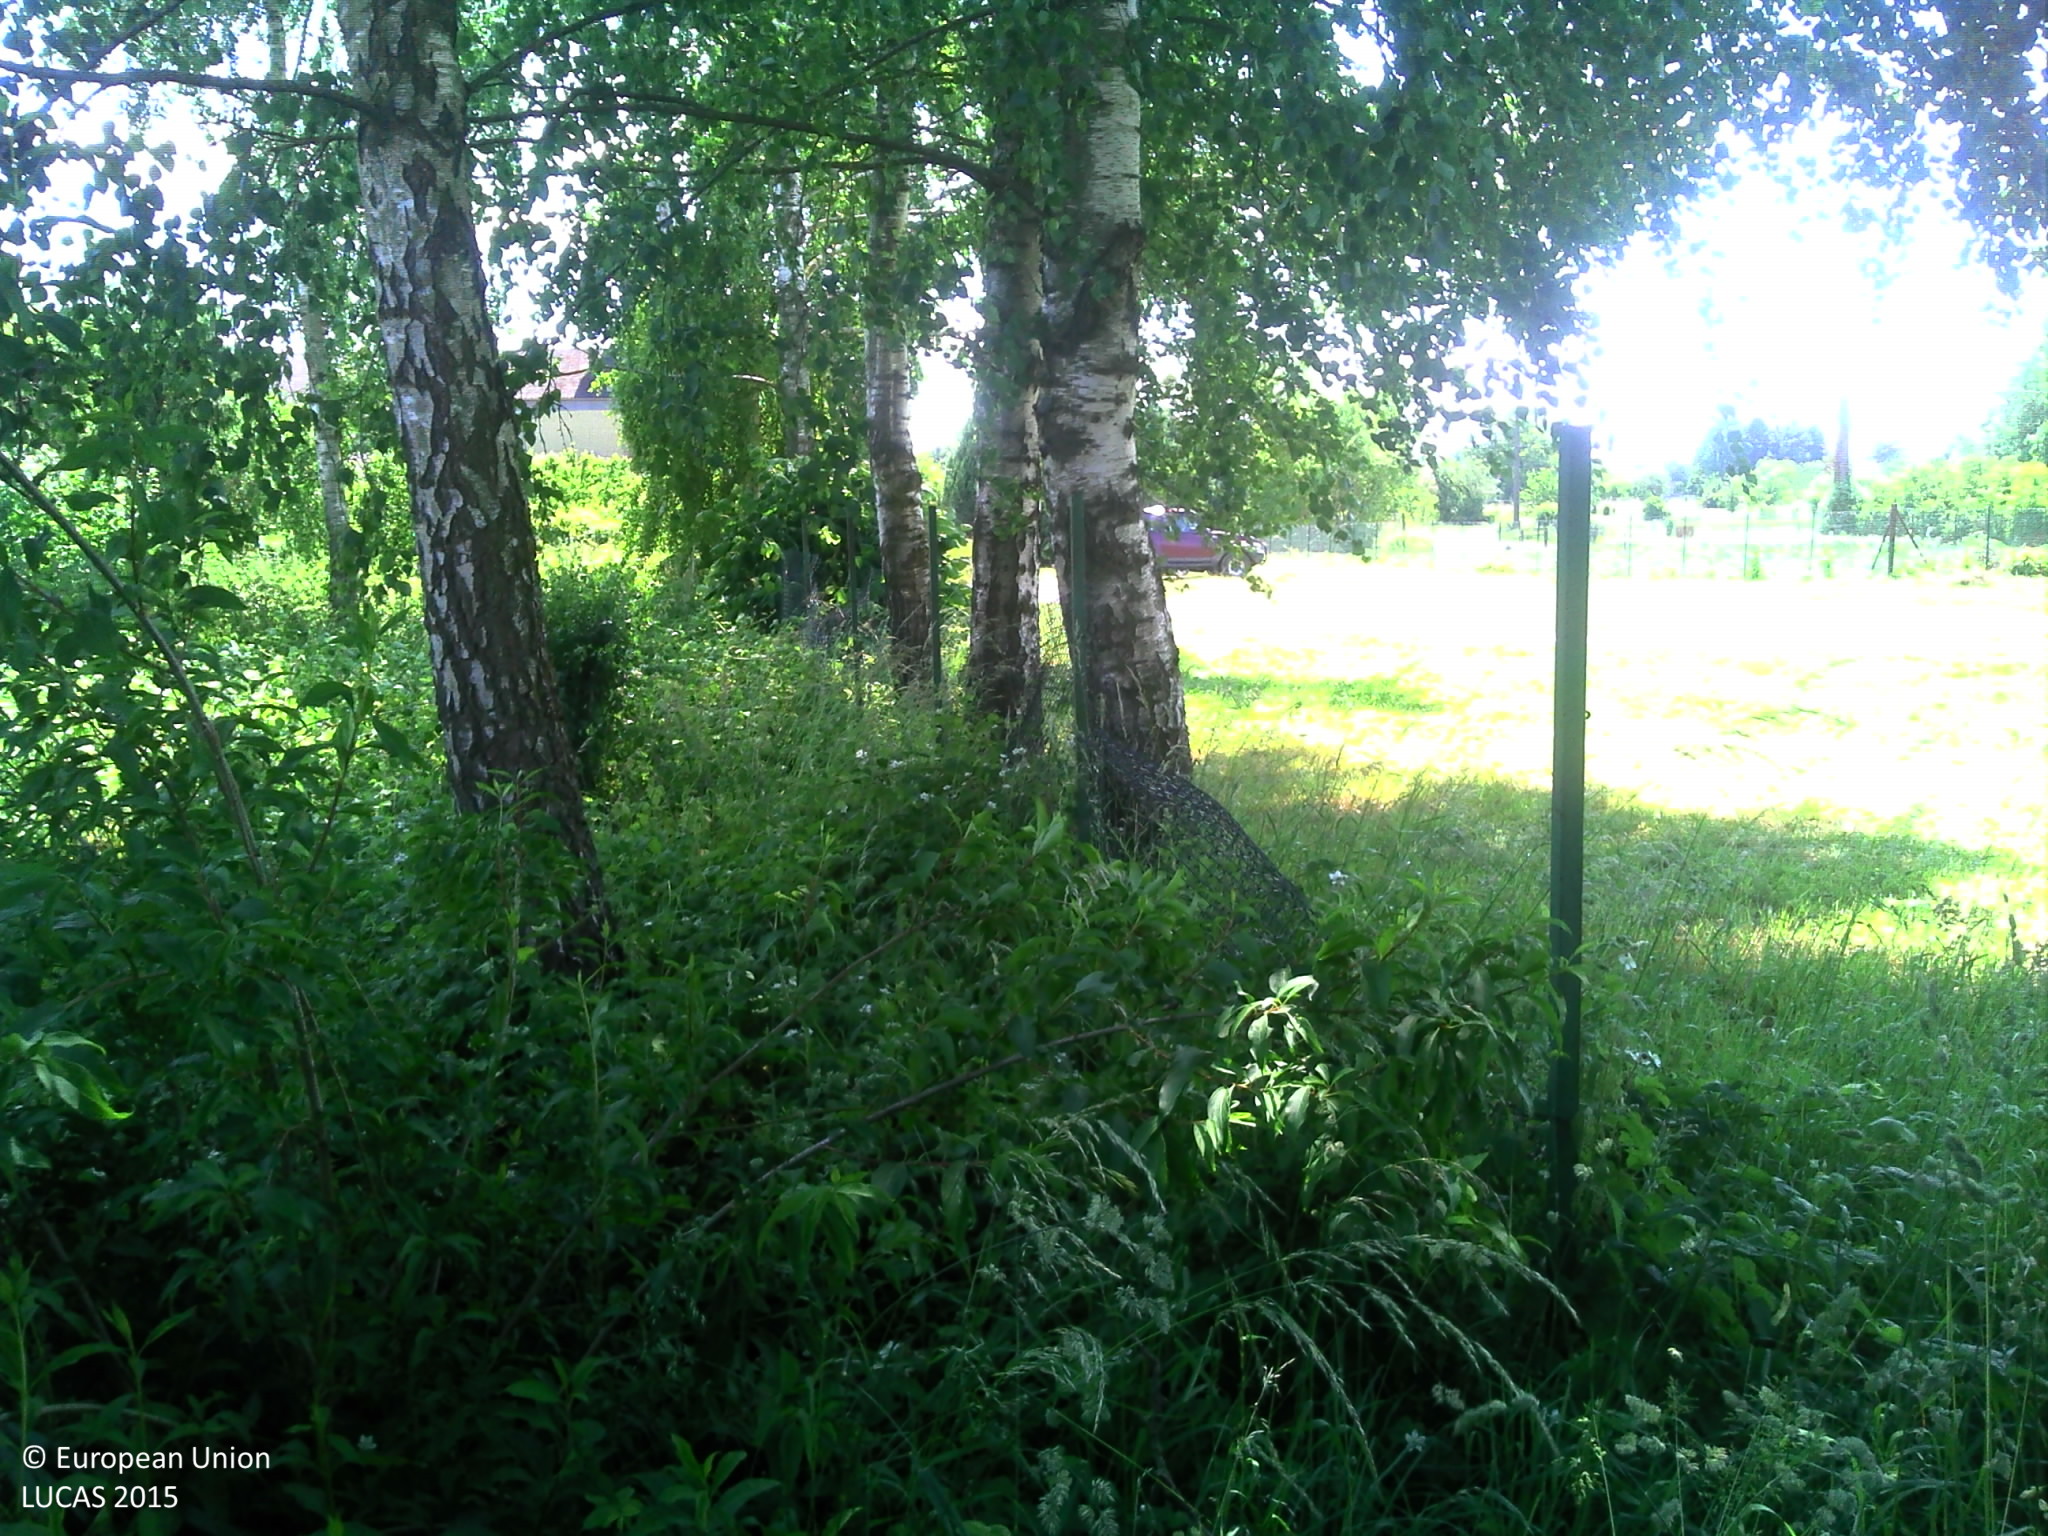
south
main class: Woodland
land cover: Broadleaved woodland
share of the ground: > 75 %
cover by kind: broadleaved forest trees 100 %
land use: Semi-natural and natural areas not in use
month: June
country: FR
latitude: 49.6310
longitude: 4.0275
